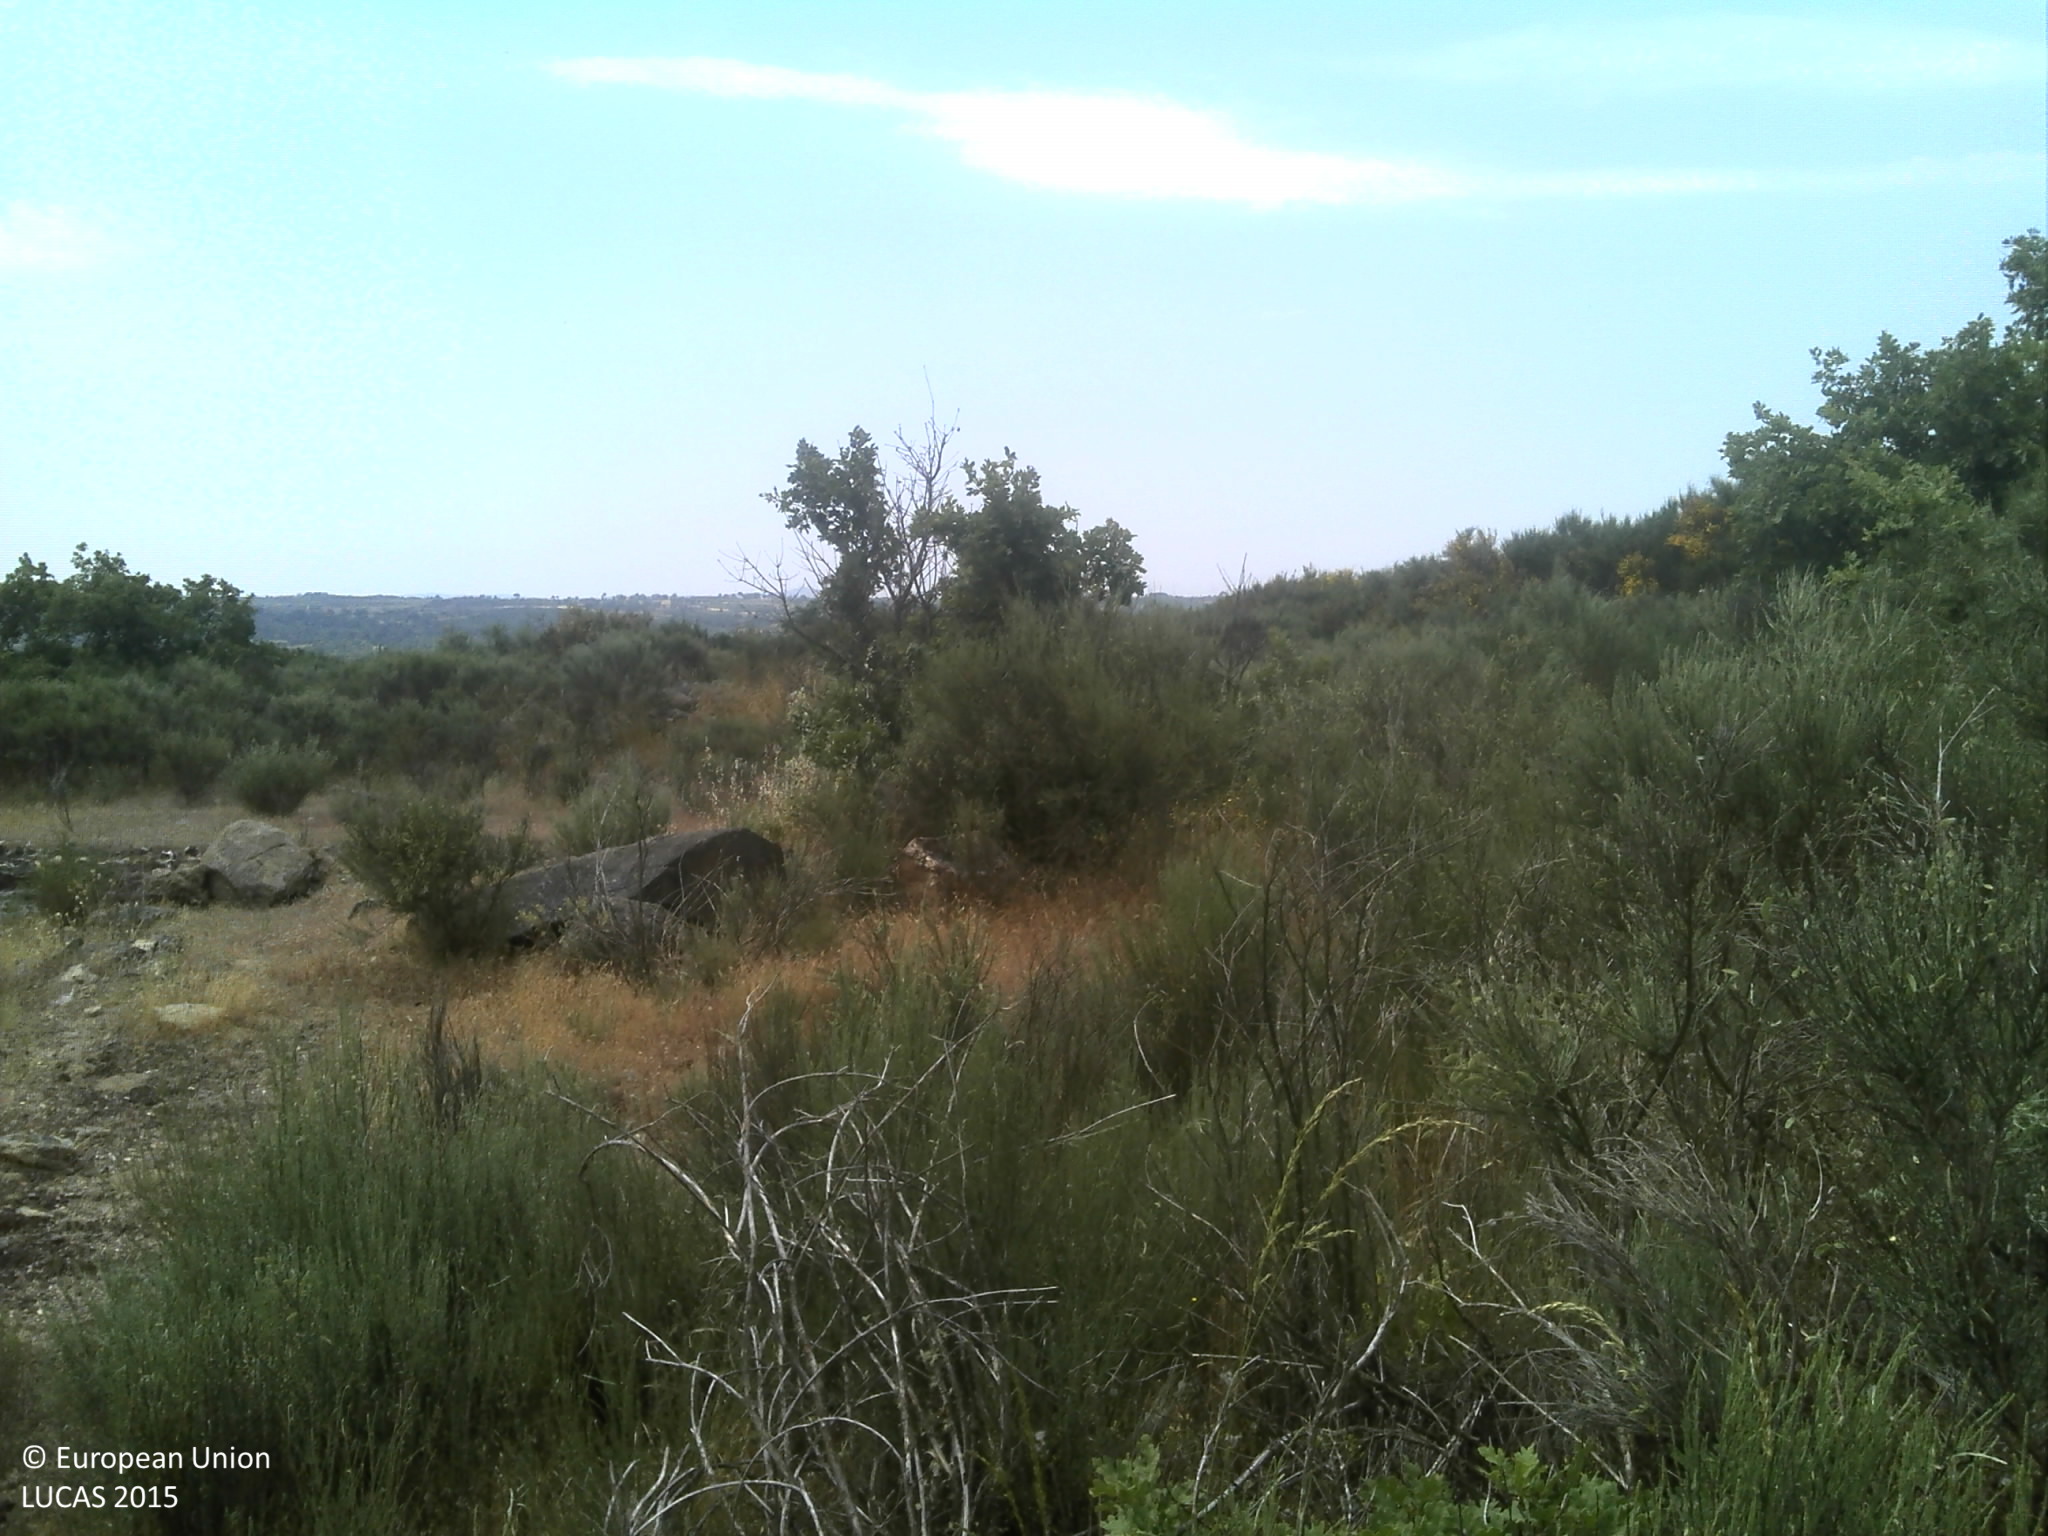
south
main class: Shrubland
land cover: Shrubland with sparse tree cover
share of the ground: 50 - 75 %
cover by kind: shrubs 75 %, unconsolidated bare surface 20 %, broadleaved forest trees 5 %
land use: Semi-natural and natural areas not in use
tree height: < 5 m
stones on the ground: 25 - 50 %
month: June
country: PT
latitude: 40.5218
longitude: -7.1108
